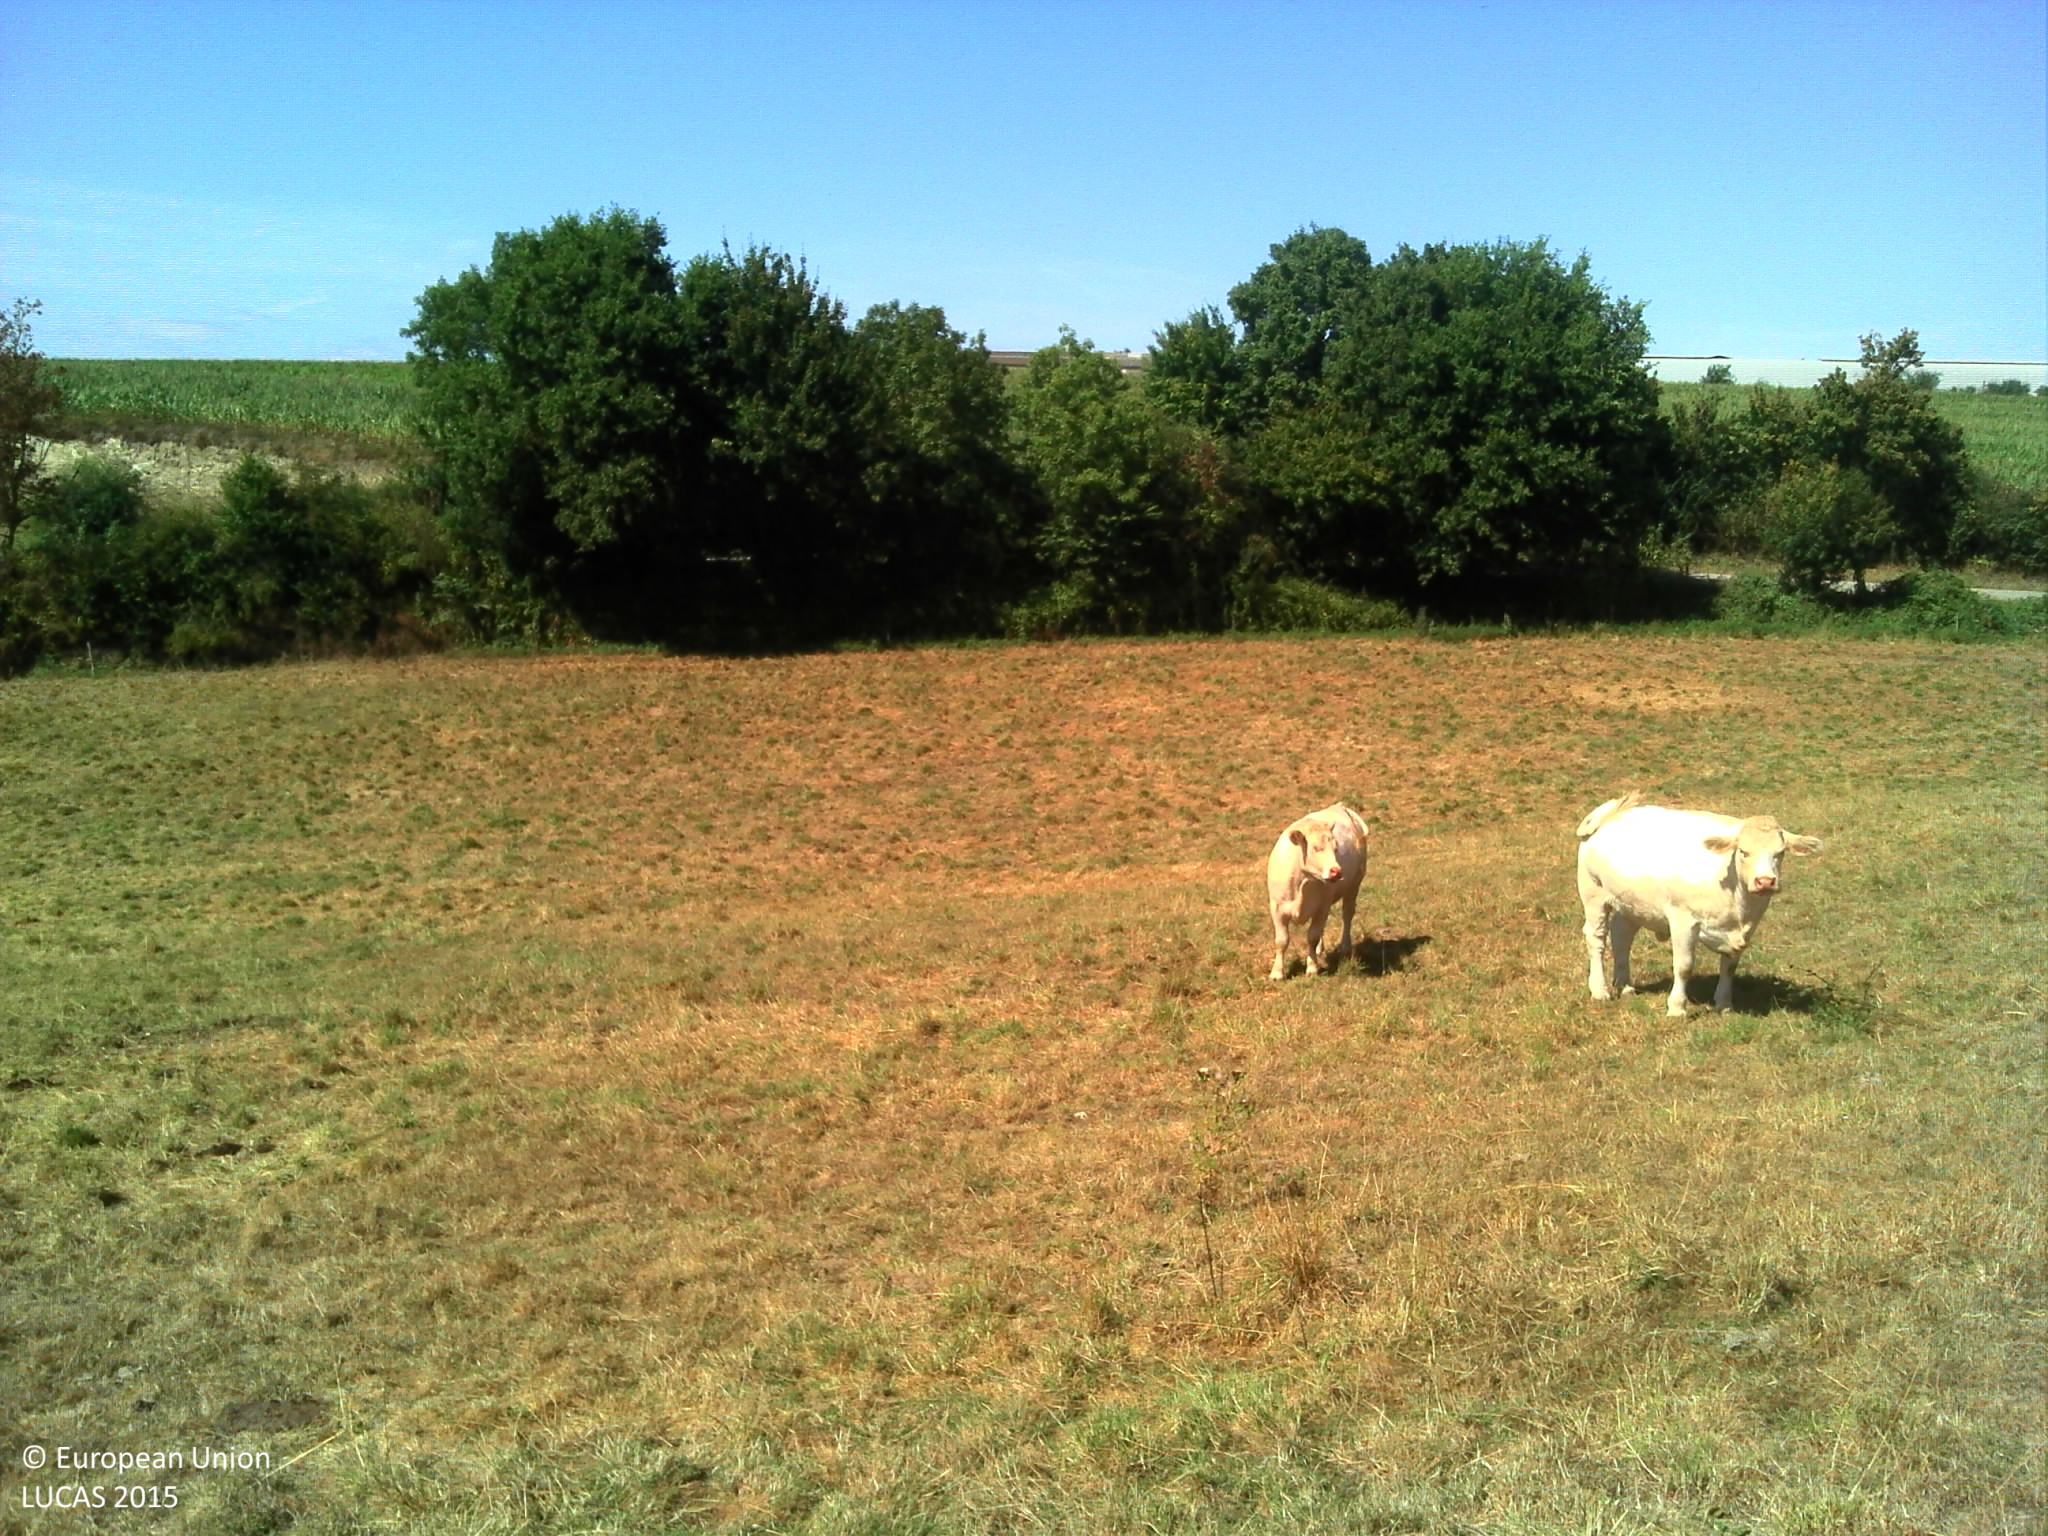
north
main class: Grassland
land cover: Grassland without tree/shrub cover
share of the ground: > 75 %
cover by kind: herbaceous plants 100 %
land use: Agriculture (excluding fallow land and kitchen gardens)
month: August
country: FR
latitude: 46.7683
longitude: -1.1259
